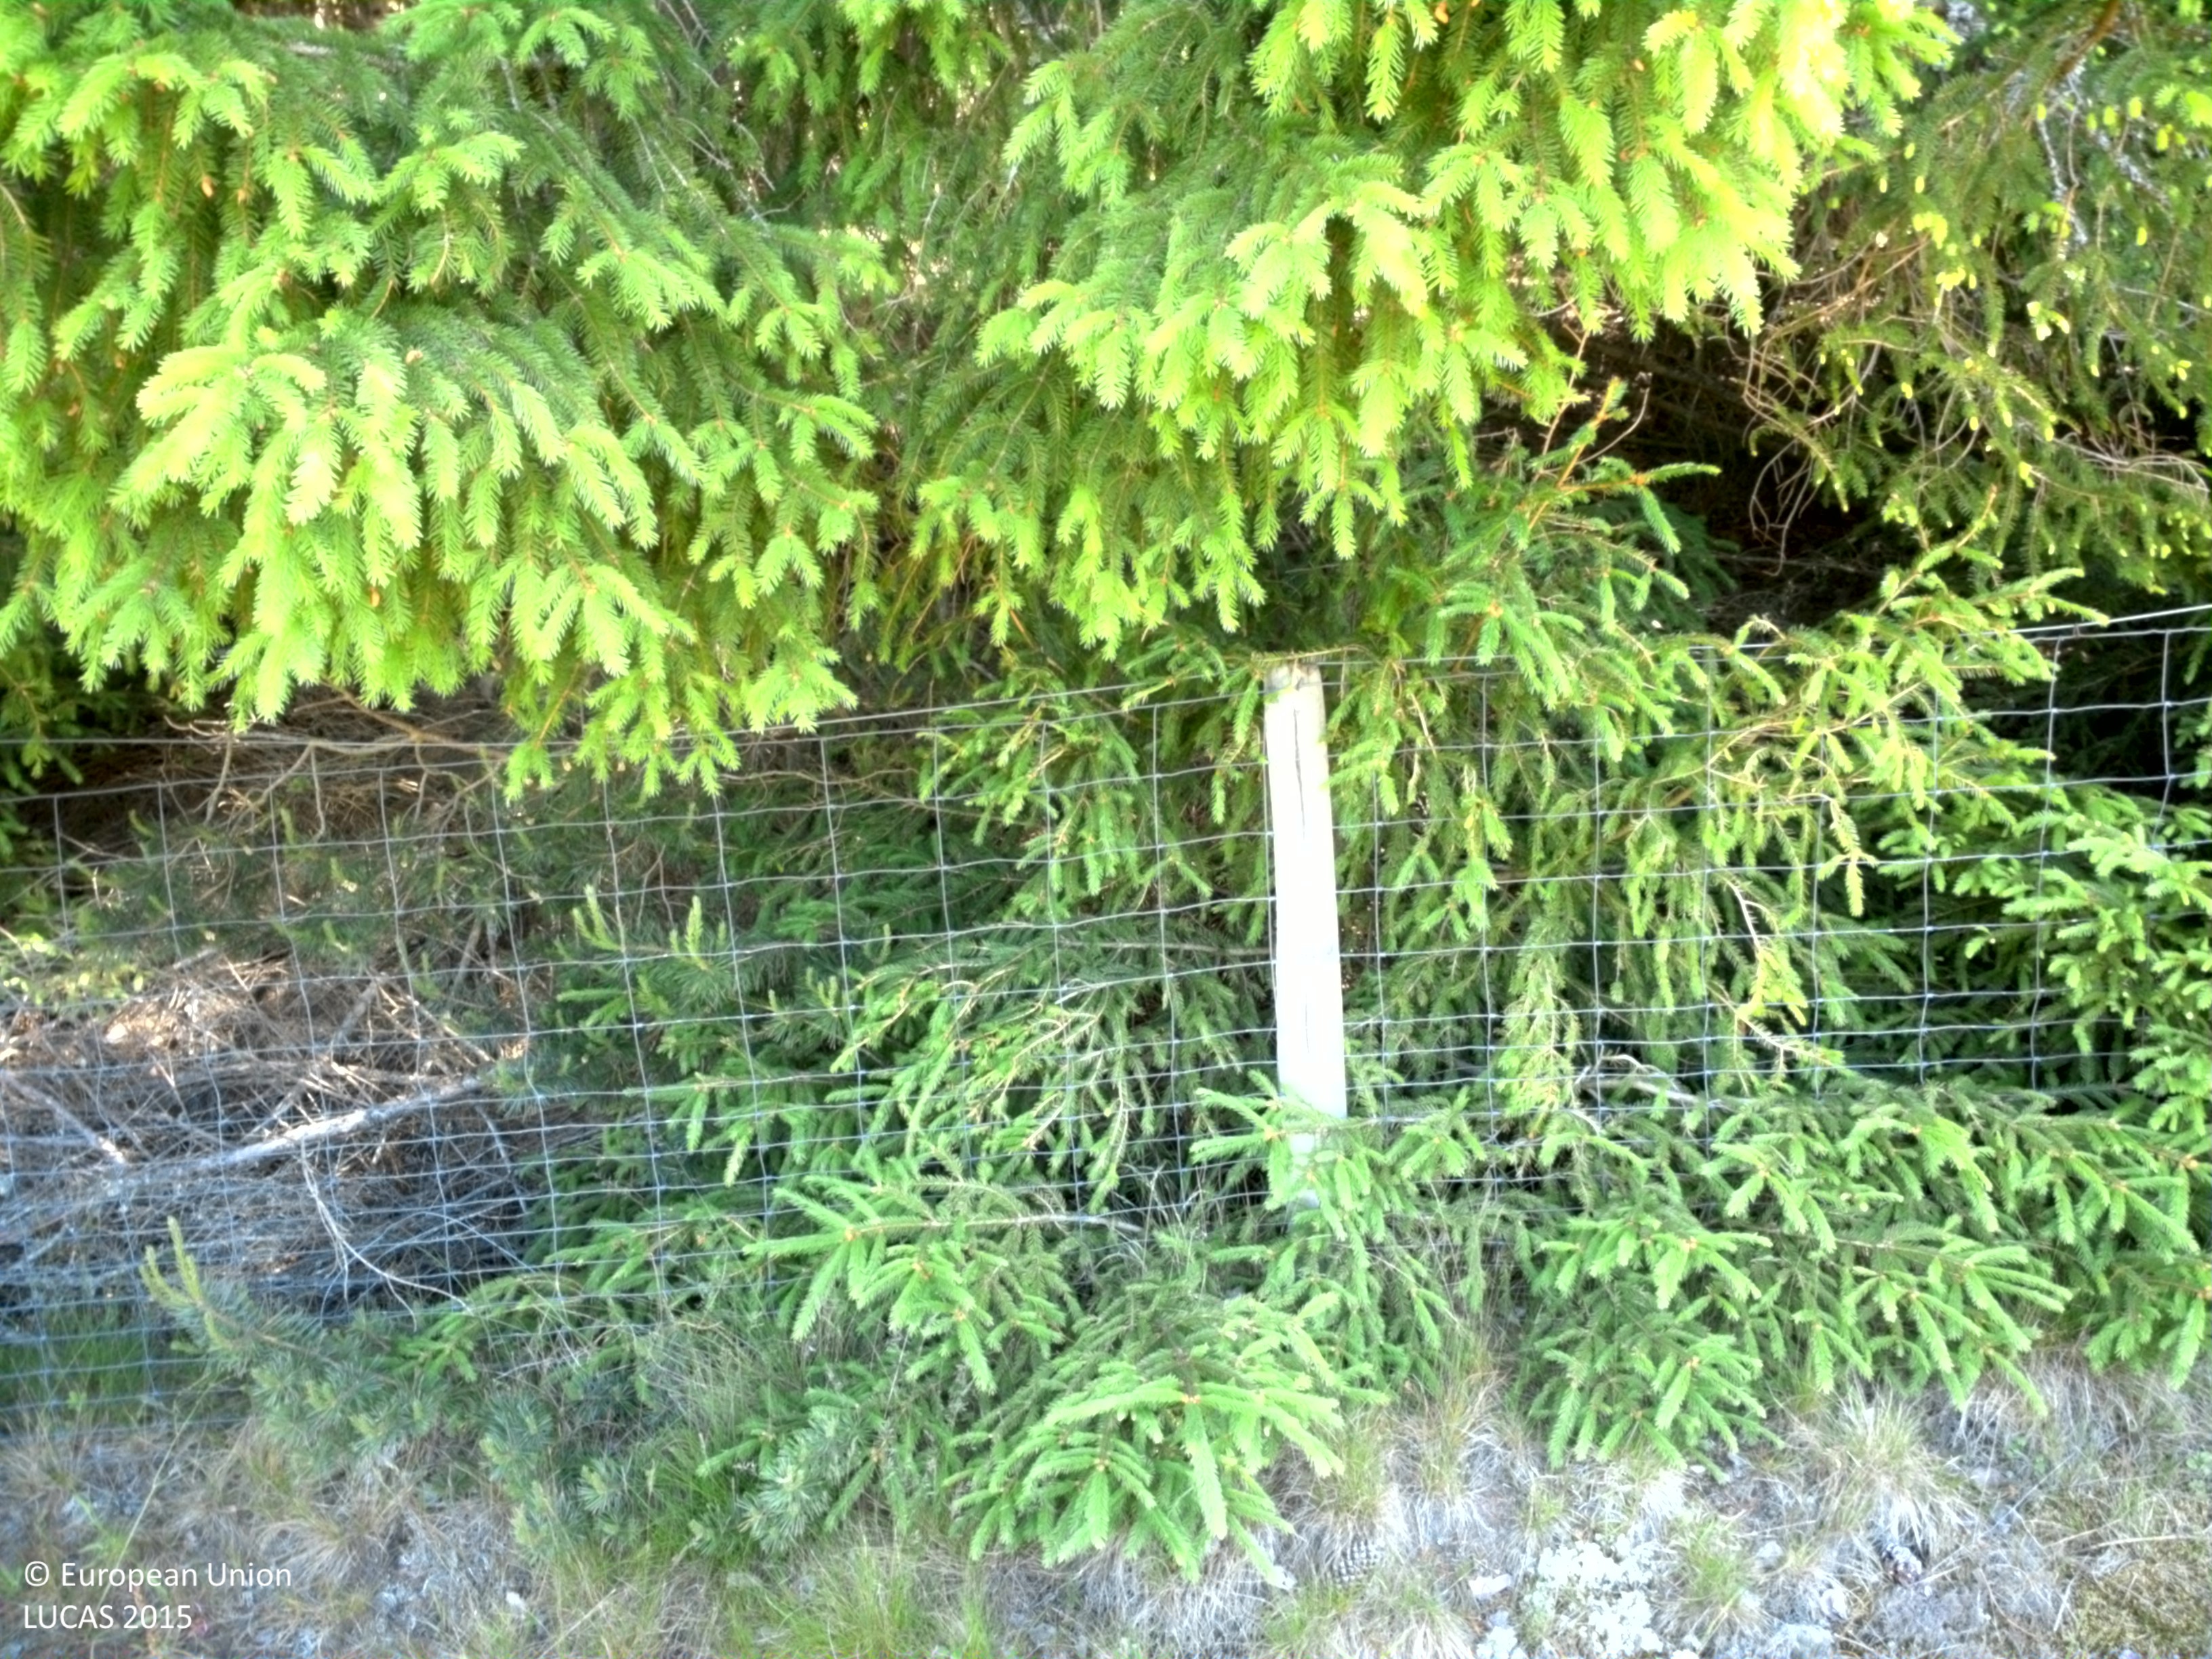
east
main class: Grassland
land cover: Grassland without tree/shrub cover
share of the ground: > 75 %
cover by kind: herbaceous plants 100 %
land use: Agriculture (excluding fallow land and kitchen gardens)
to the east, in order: Grassland without tree/shrub cover; Fences; Spruce dominated coniferous woodland; Spruce dominated mixed woodland
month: June
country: SE
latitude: 58.6008
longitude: 14.3126
